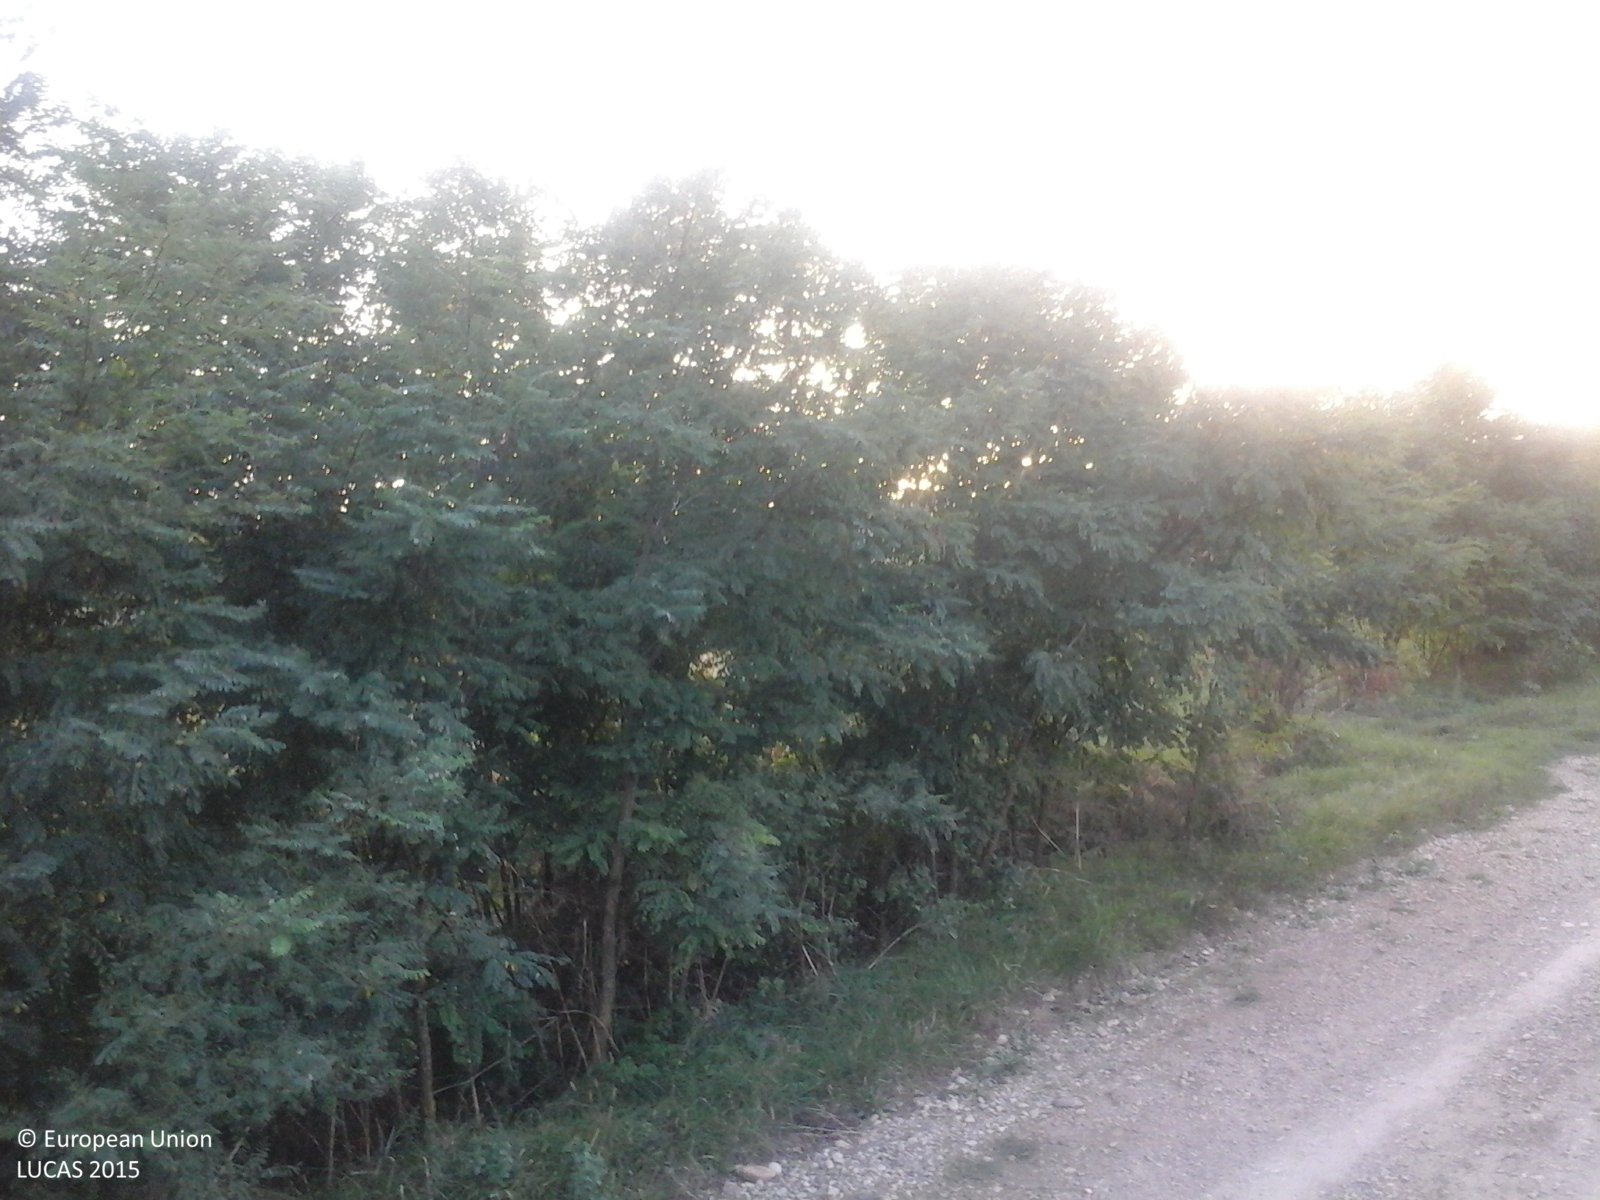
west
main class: Cropland
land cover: Maize
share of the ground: > 75 %
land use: Agriculture (excluding fallow land and kitchen gardens)
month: September
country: RO
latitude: 46.7346
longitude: 24.0426
